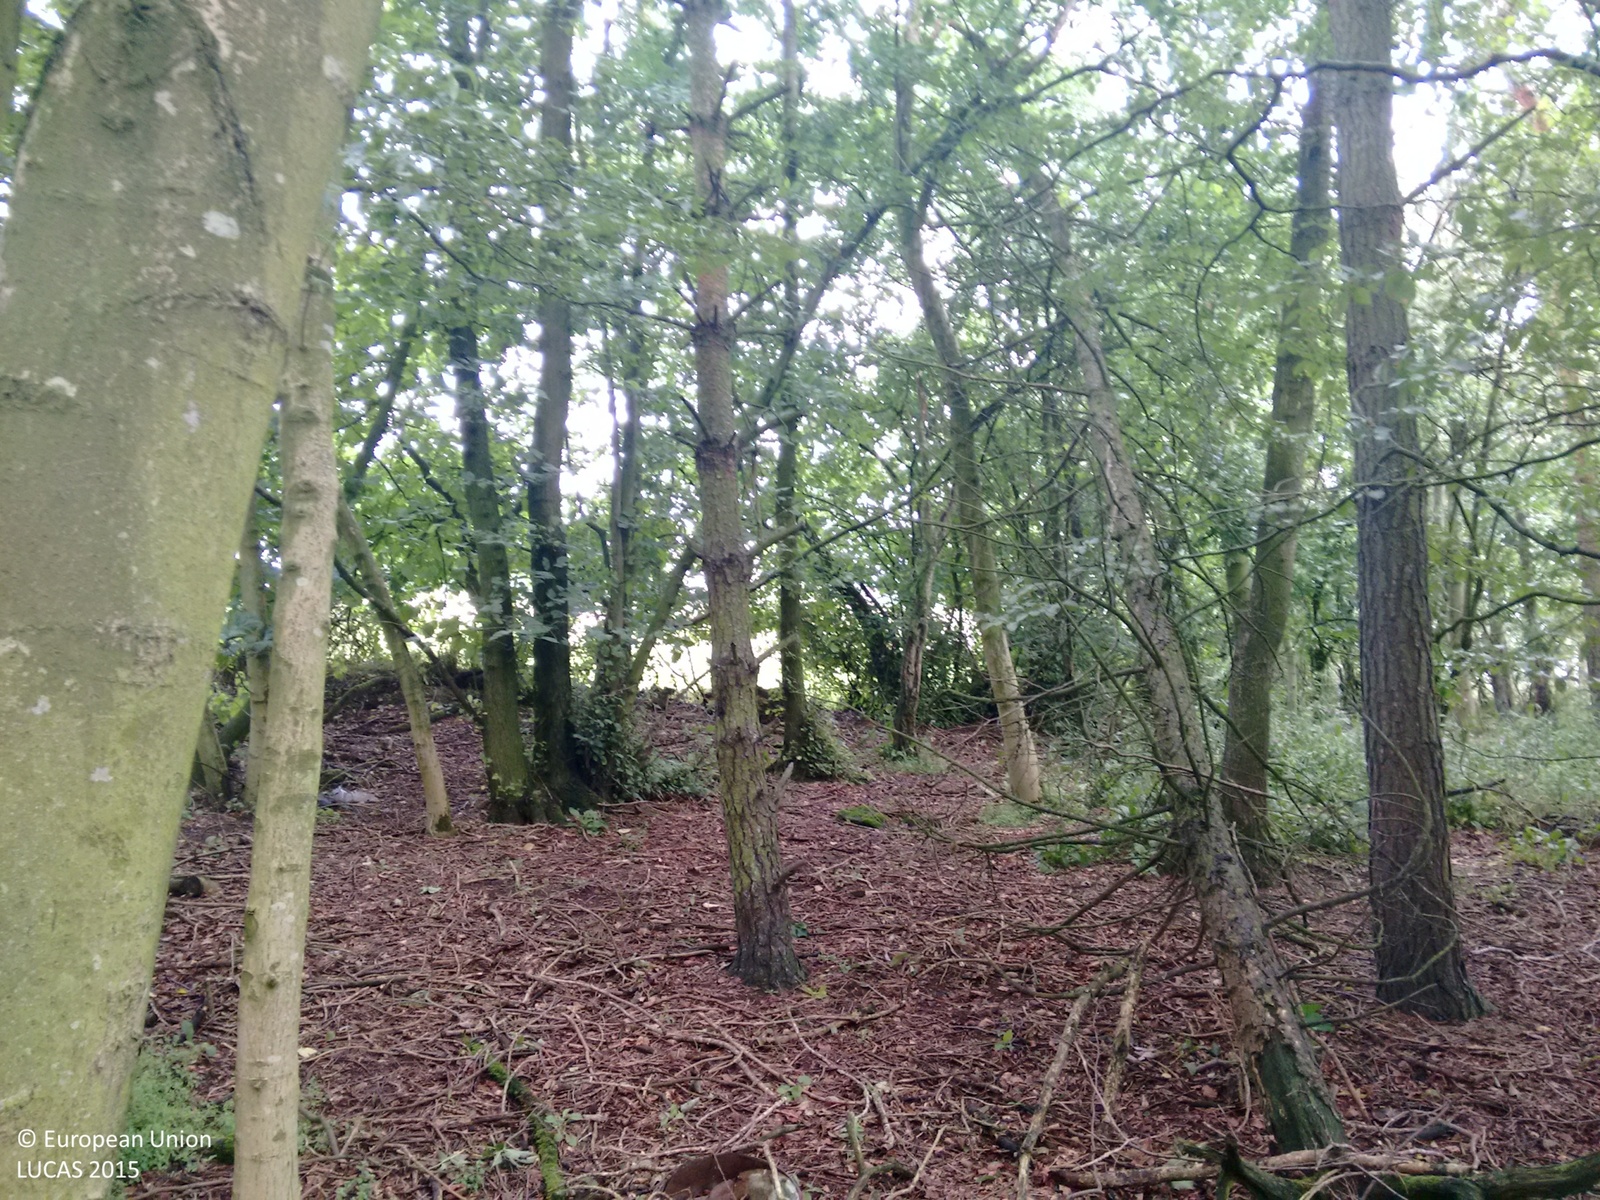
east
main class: Woodland
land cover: Broadleaved woodland
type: beech forest
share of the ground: > 75 %
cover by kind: broadleaved forest trees 100 %
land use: Semi-natural and natural areas not in use
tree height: > 5 m
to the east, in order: Broadleaved woodland; Fences; Grassland without tree/shrub cover; Electric lines; Grassland without tree/shrub cover; Fences; Paved roads, cycling and walking lanes; Fences; Grassland without tree/shrub cover; Fences; Lines of trees; Fences; Grassland without tree/shrub cover
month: July
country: GB
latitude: 56.4213
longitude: -2.9536
